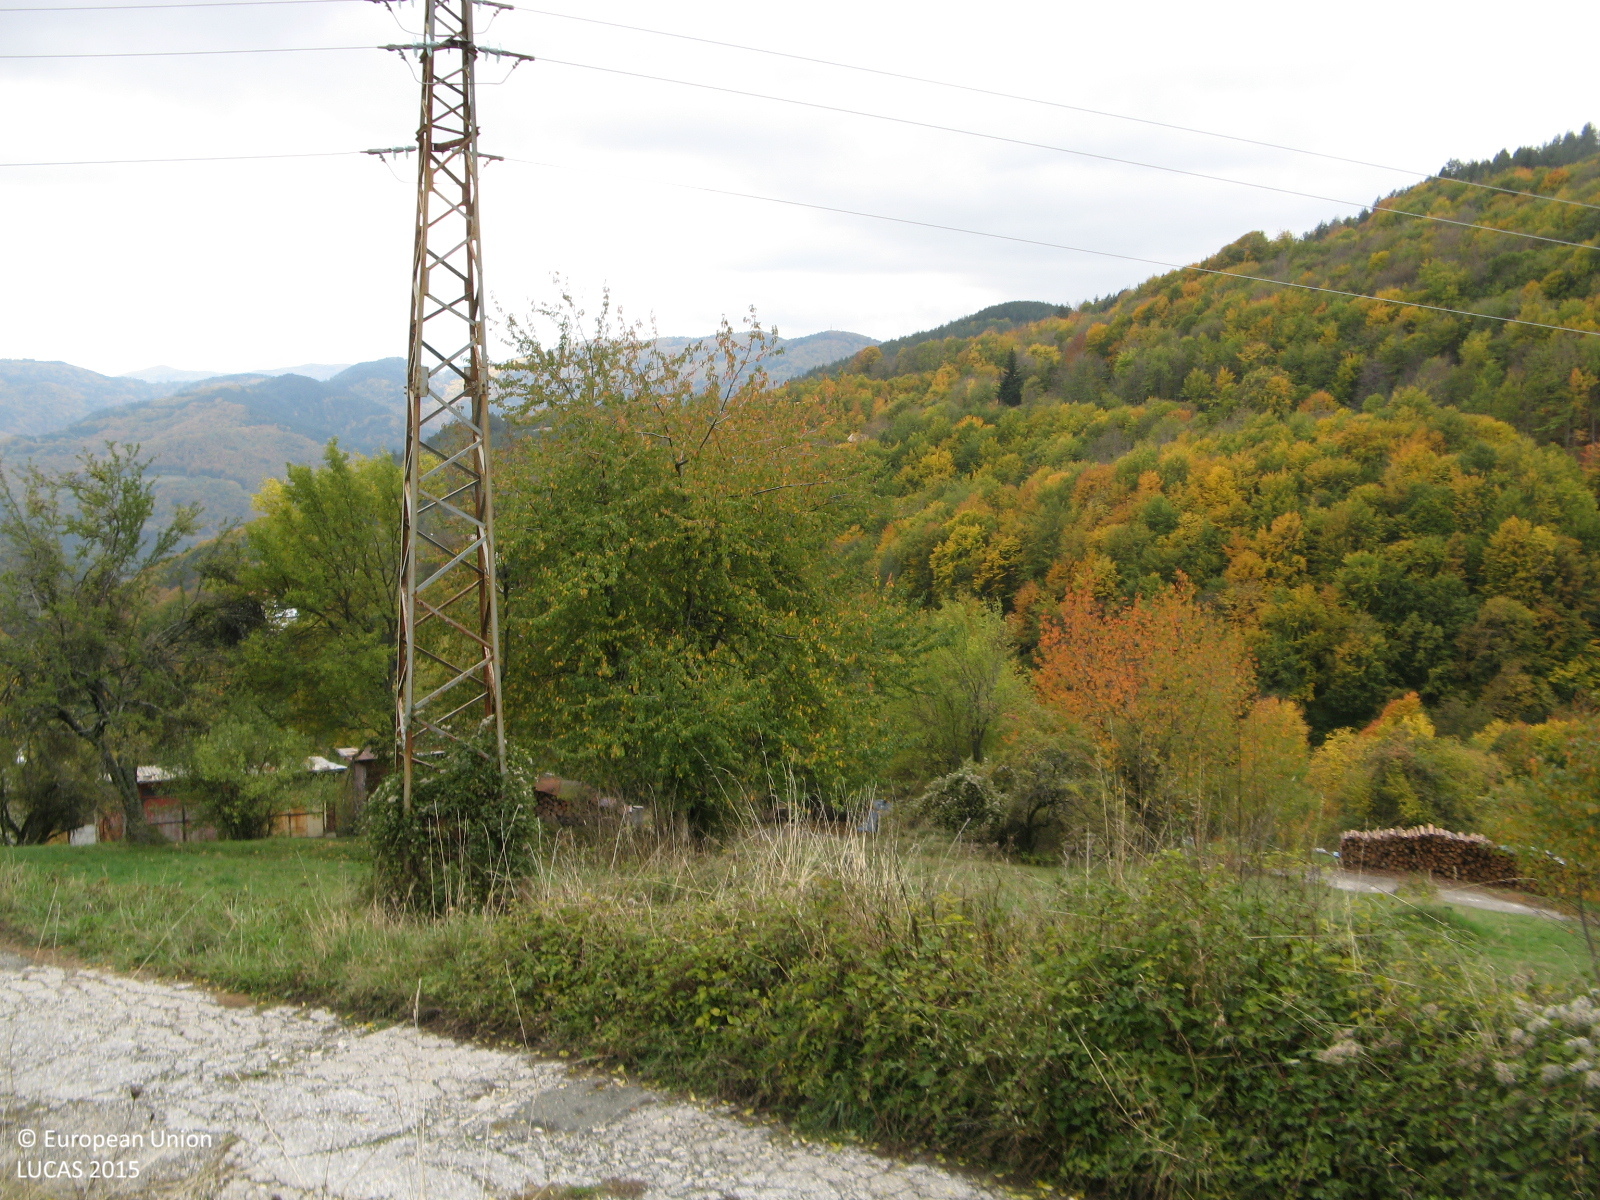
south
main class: Grassland
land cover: Grassland without tree/shrub cover
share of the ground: > 75 %
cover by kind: herbaceous plants 100 %
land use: Agriculture (excluding fallow land and kitchen gardens)
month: October
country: BG
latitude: 41.5979
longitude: 24.7906
